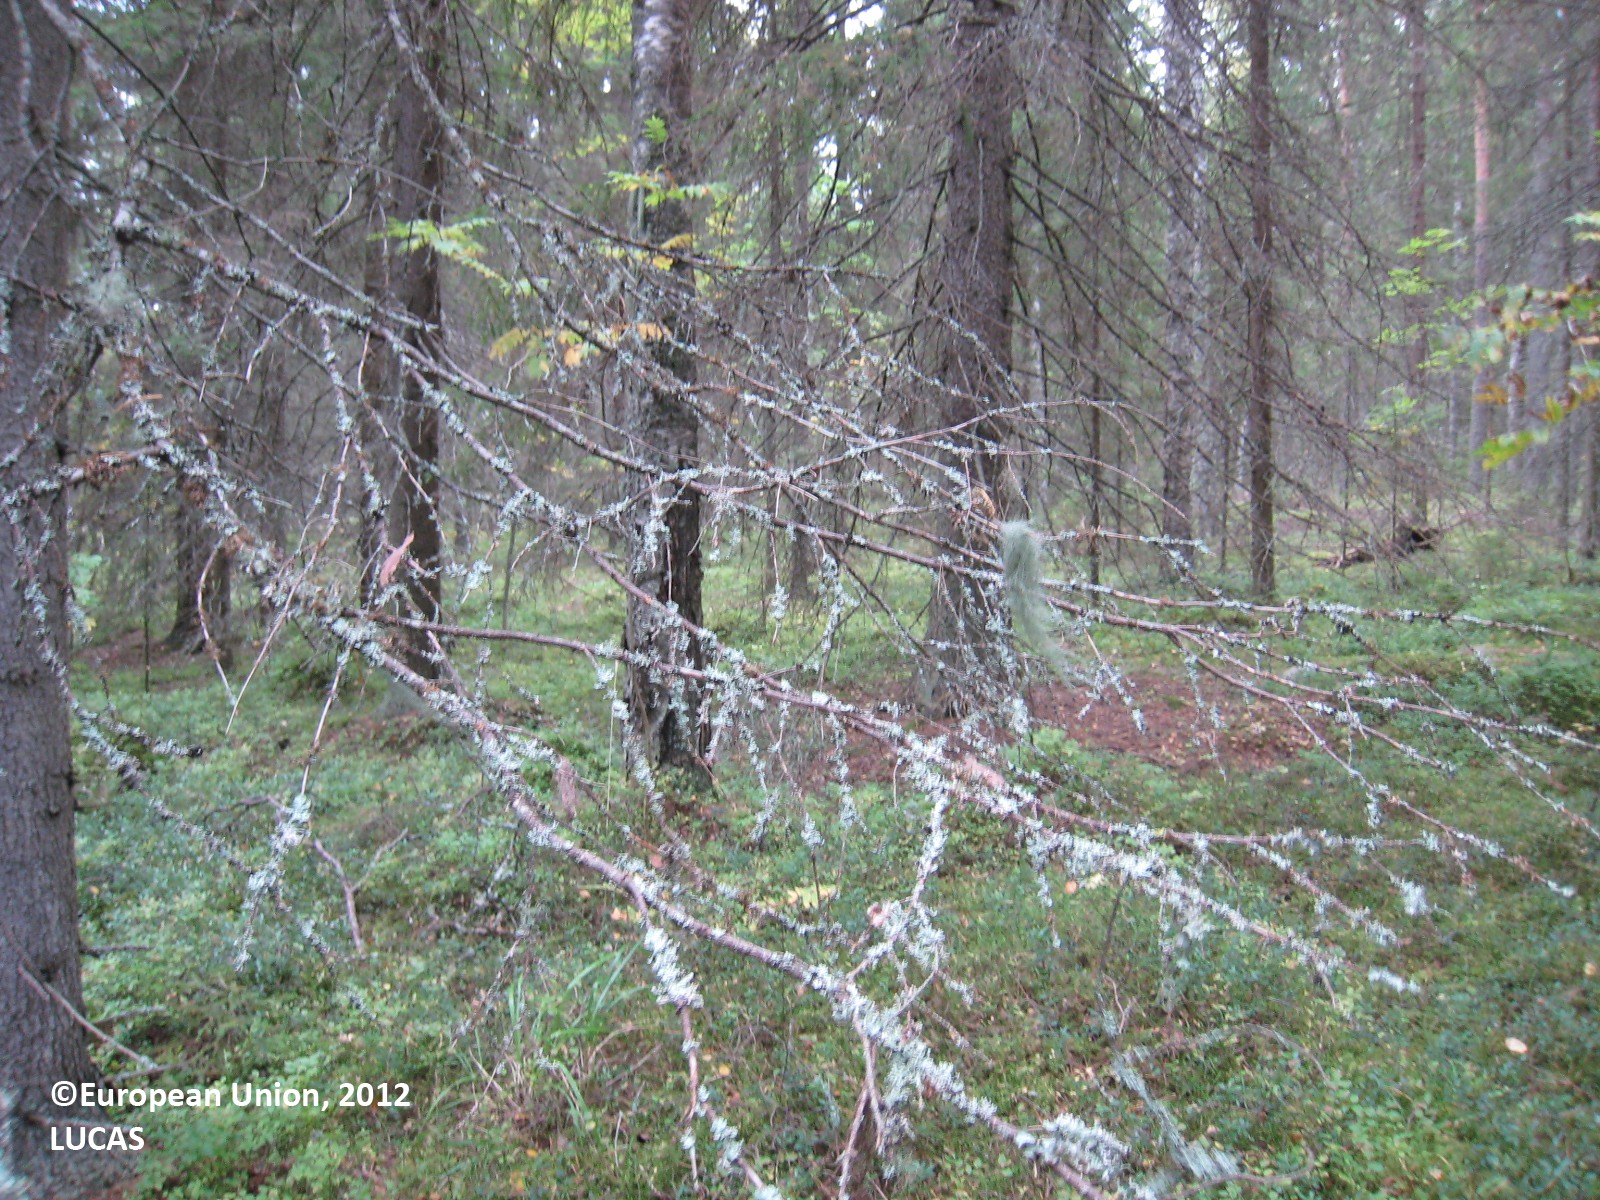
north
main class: Woodland
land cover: Spruce dominated coniferous woodland
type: boreal forest
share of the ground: > 75 %
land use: Forestry
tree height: > 5 m
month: September
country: FI
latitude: 62.7233
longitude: 26.5464
